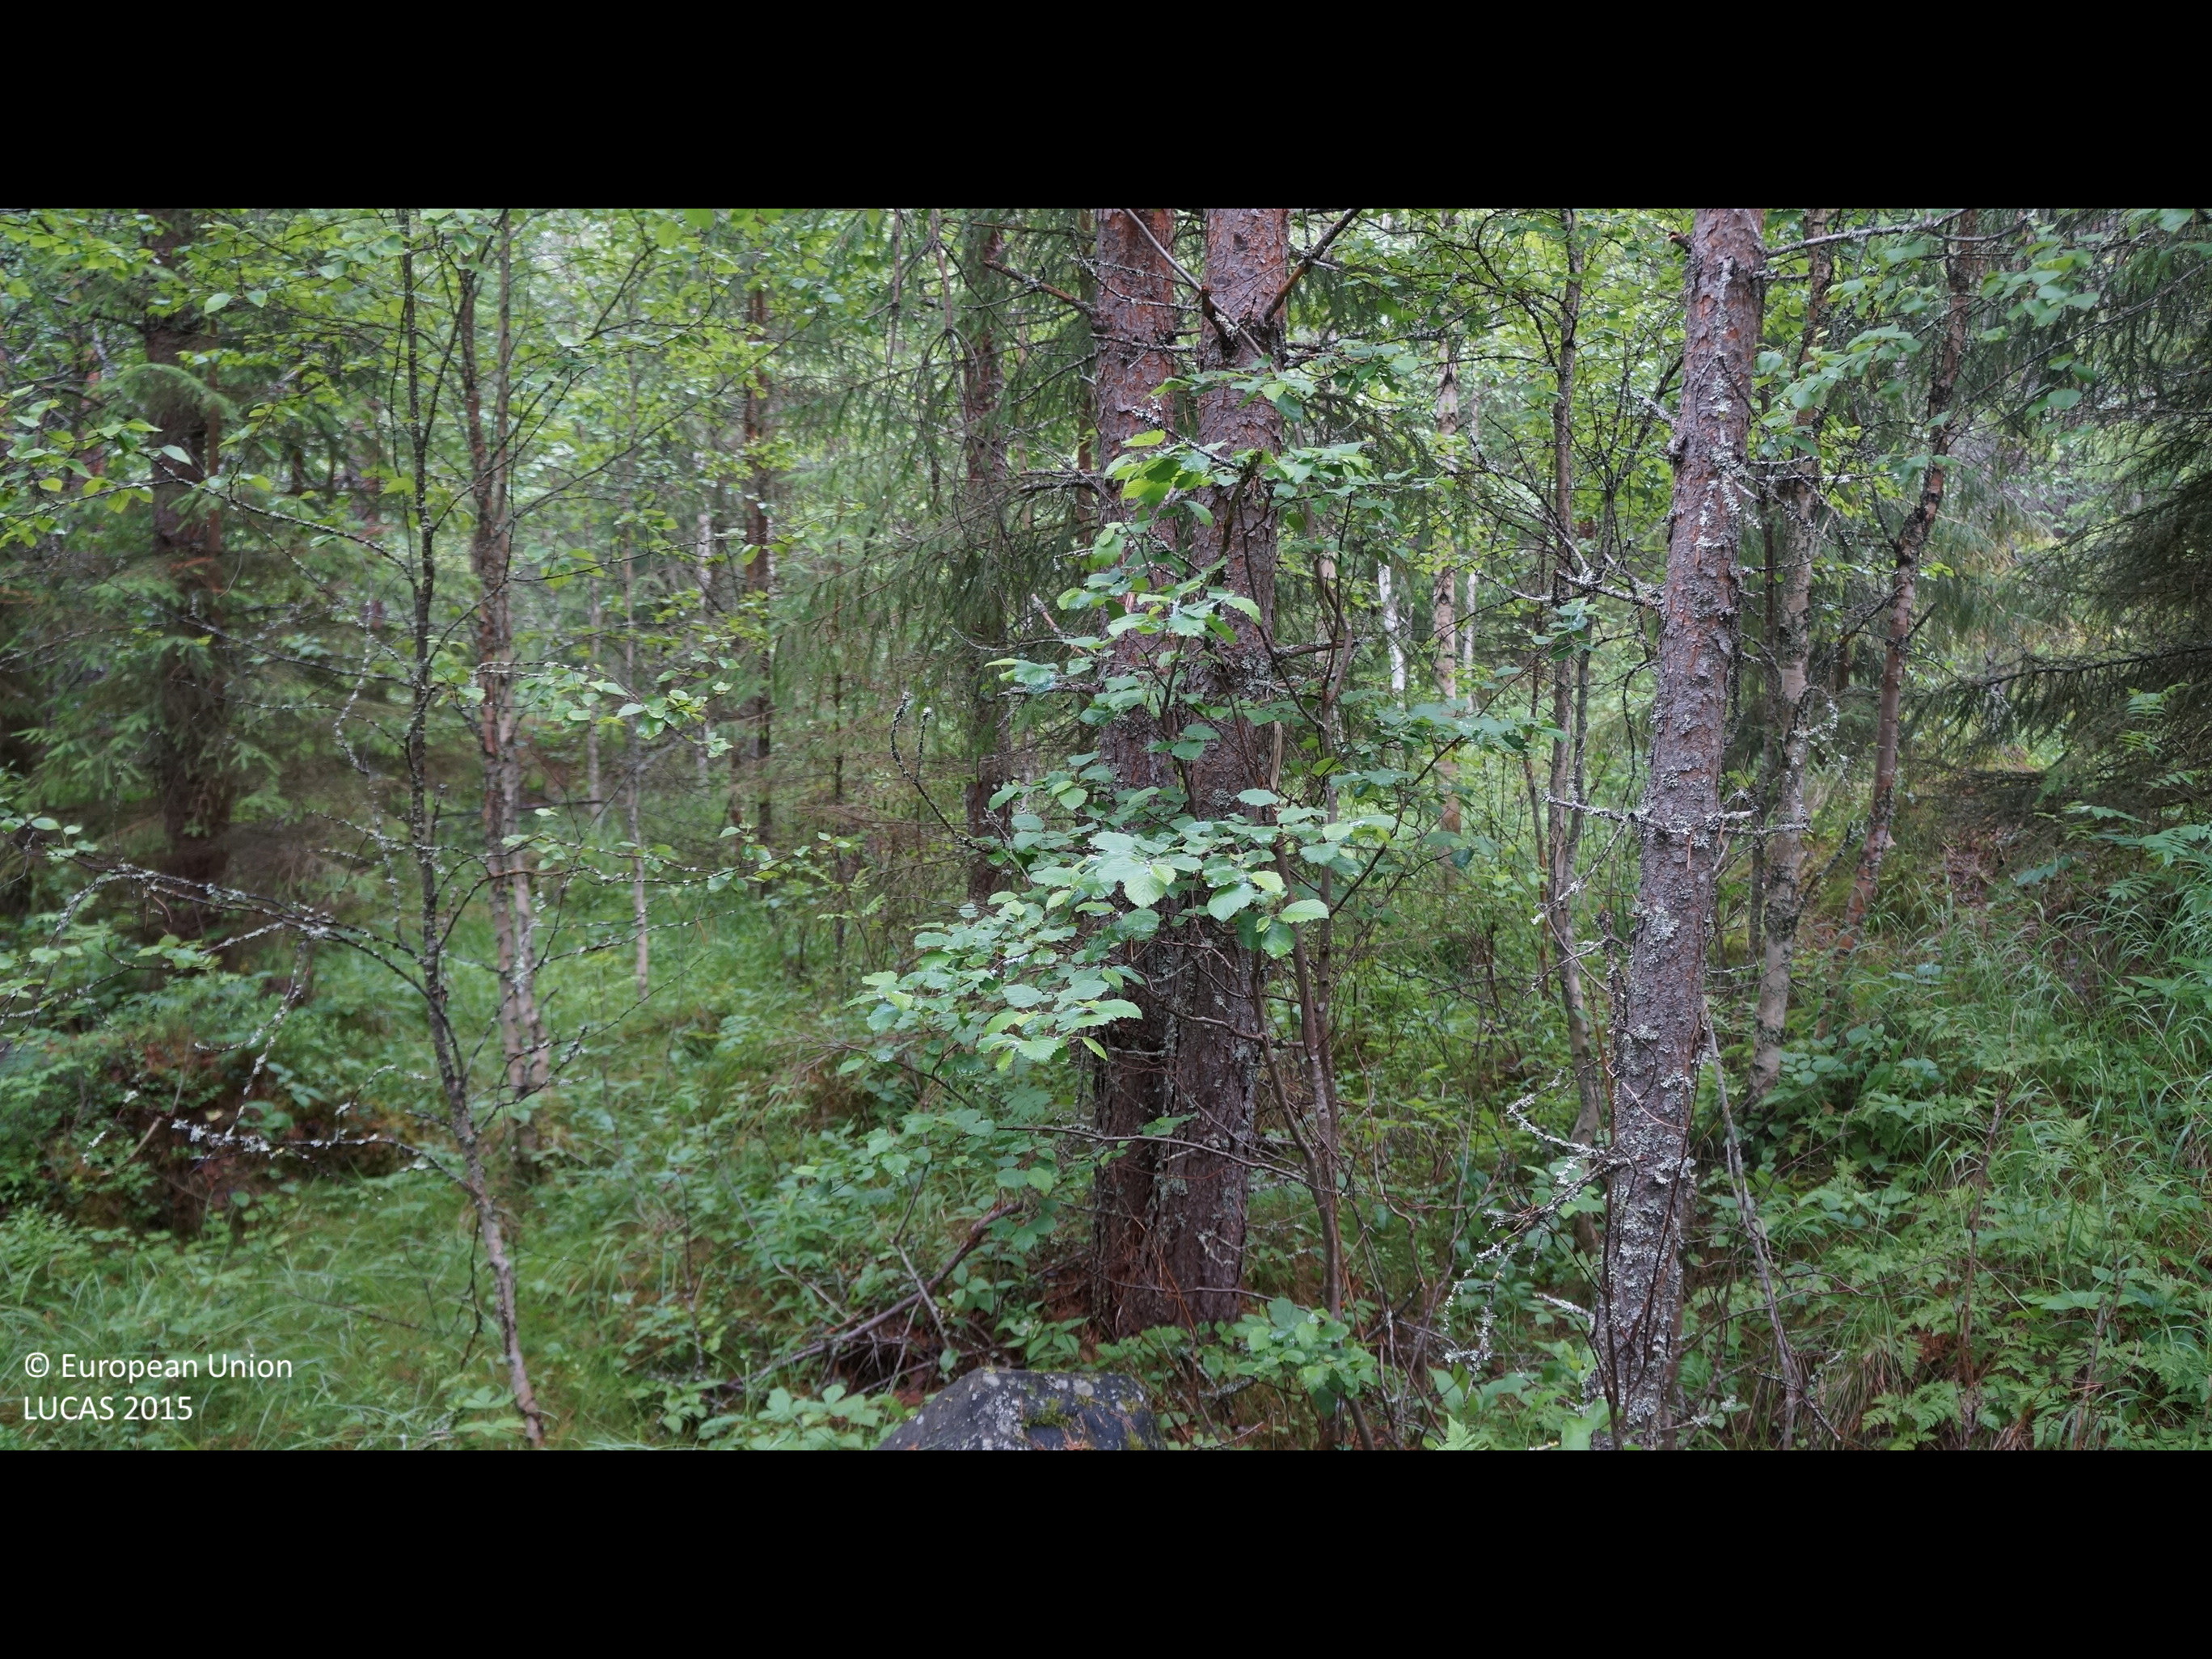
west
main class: Woodland
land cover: Pine dominated mixed woodland
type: boreal forest
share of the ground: > 75 %
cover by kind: coniferous forest trees 55 %, broadleaved forest trees 20 %, herbaceous plants 15 %, shrubs 10 %
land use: Forestry
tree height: > 5 m
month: July
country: FI
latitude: 64.4152
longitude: 24.8329
